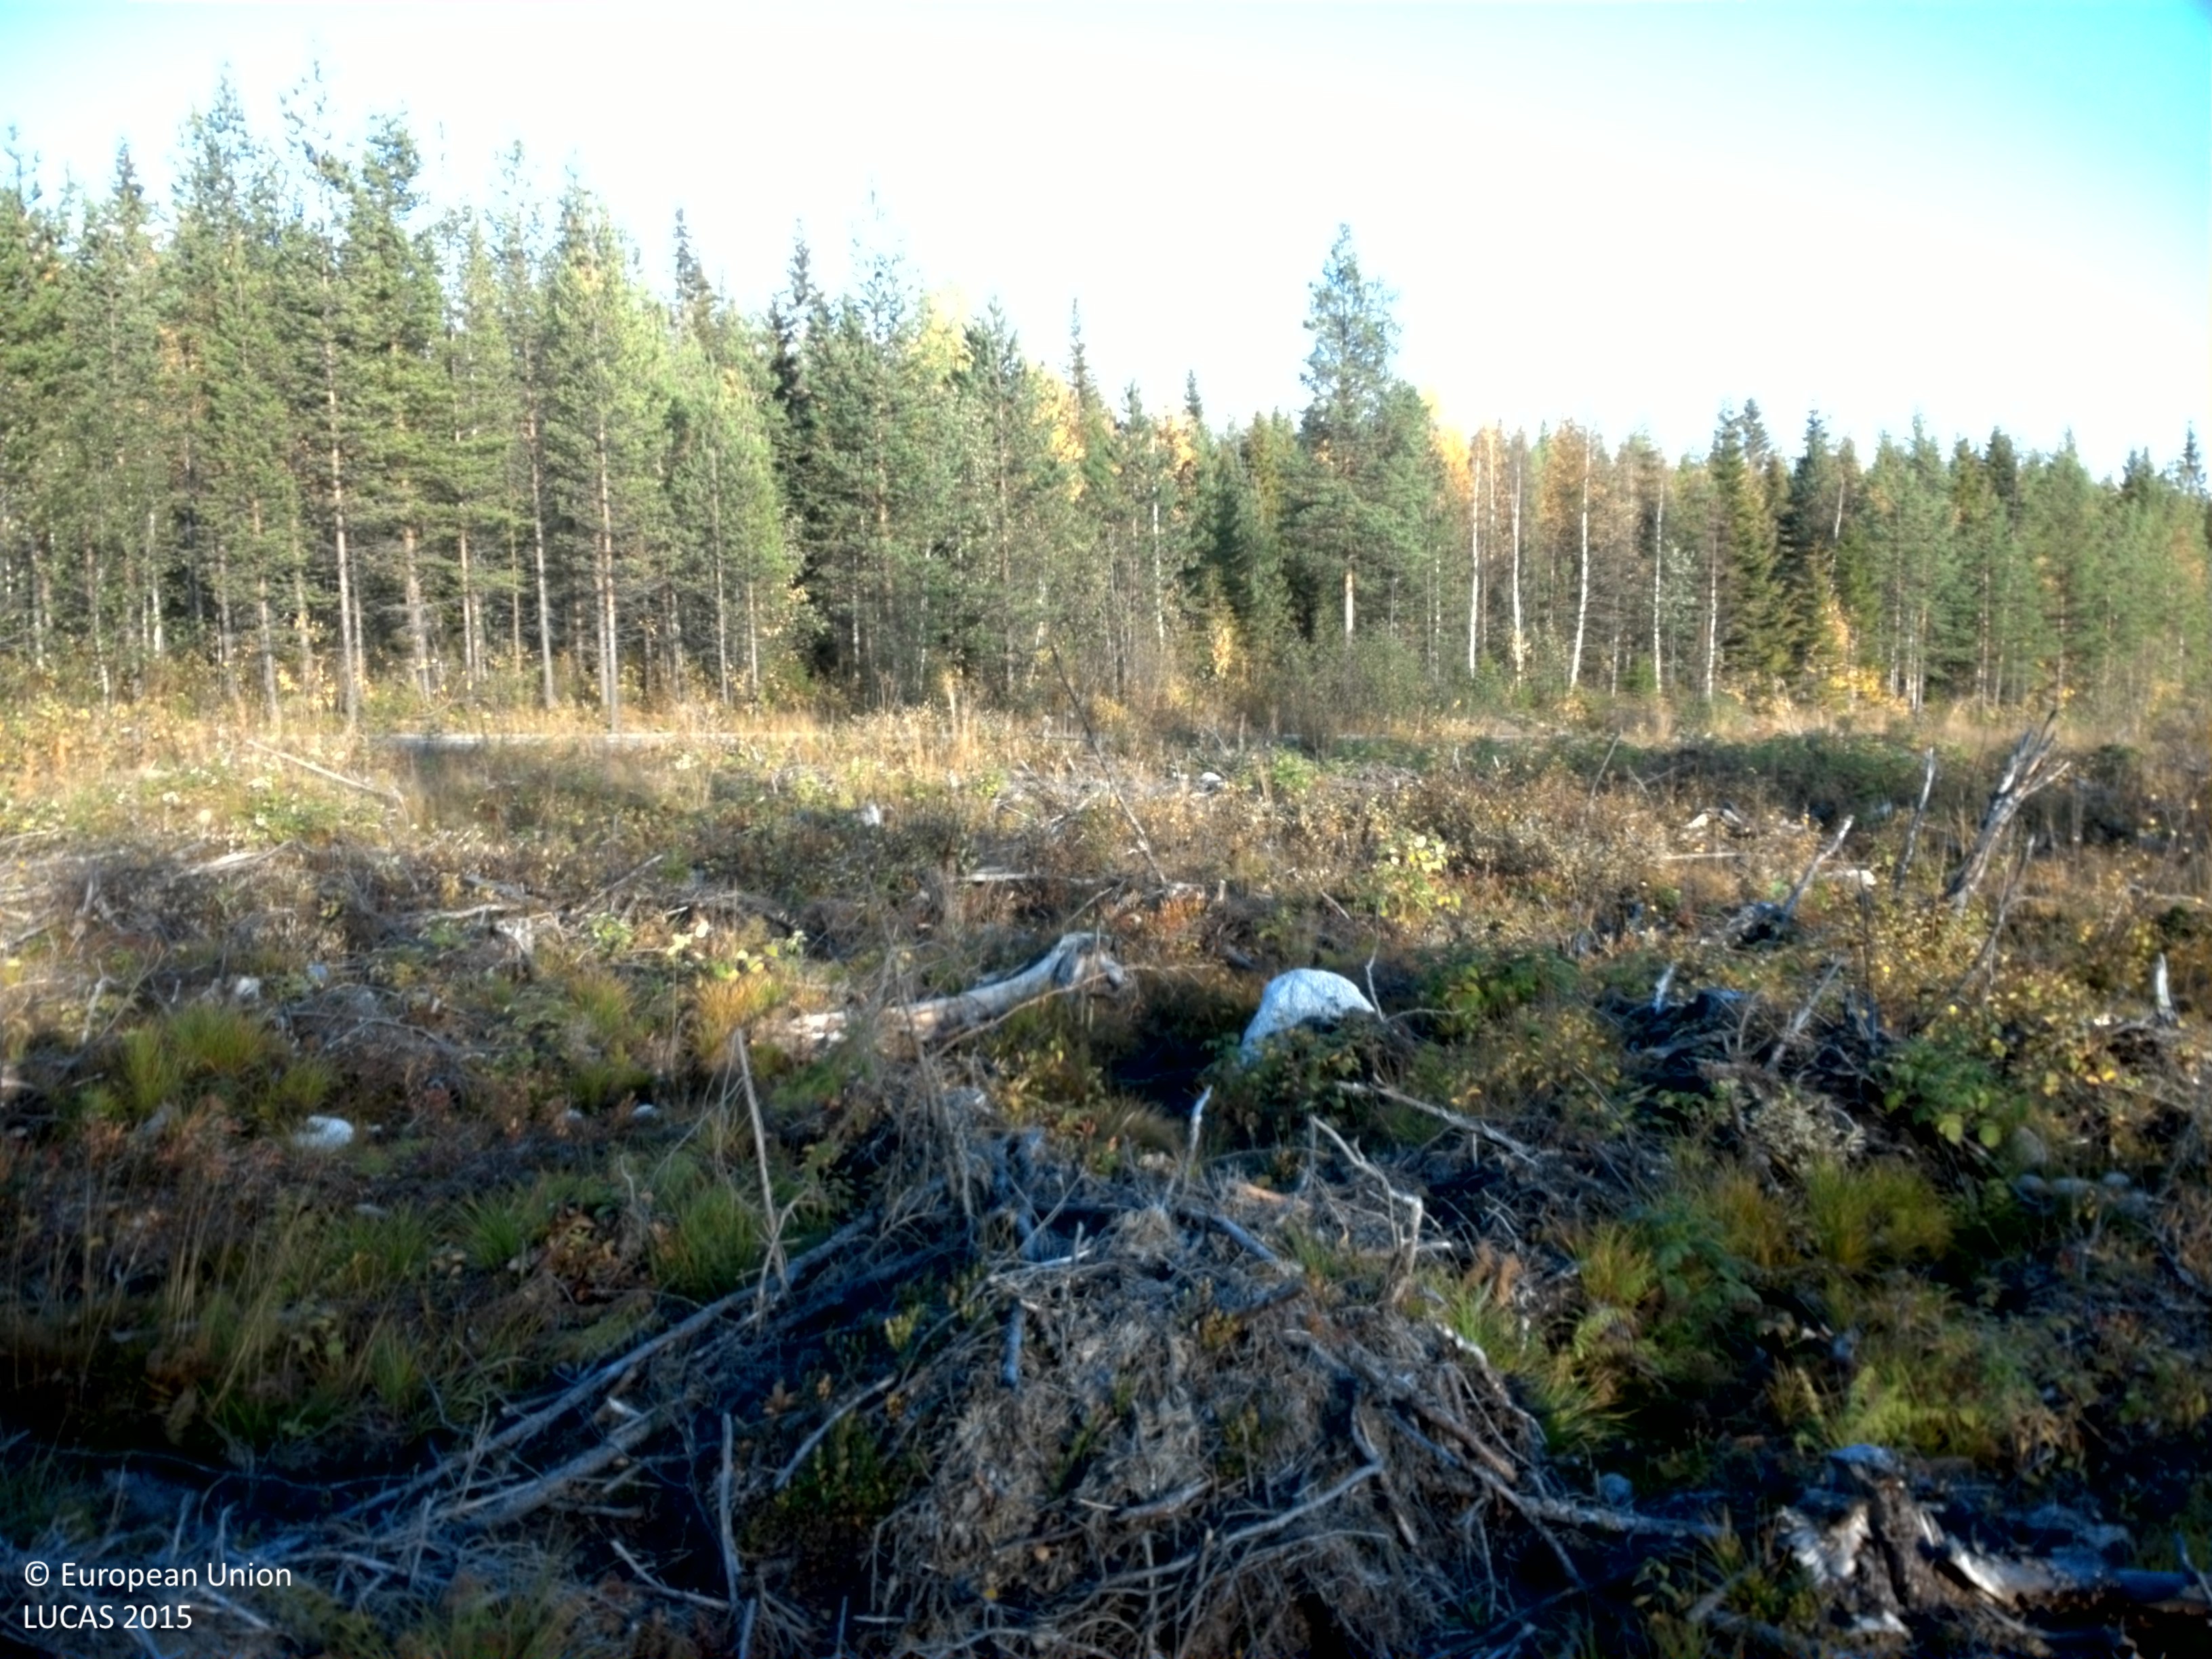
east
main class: Shrubland
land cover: Shrubland with sparse tree cover
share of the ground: 25 - 50 %
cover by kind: shrubs 35 %, herbaceous plants 30 %, unconsolidated bare surface 10 %, broadleaved forest trees 5 %, lichens and mosses 5 %, consolidated bare surface 5 %
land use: Forestry
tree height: < 5 m
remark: Clear cut
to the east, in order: Shrubland with sparse tree cover; Paved roads, cycling and walking lanes; Ditches and canals; Other mixed woodland; Spruce dominated mixed woodland; Other mixed woodland; Pine dominated mixed woodland
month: September
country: SE
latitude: 64.9800
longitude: 17.5712
